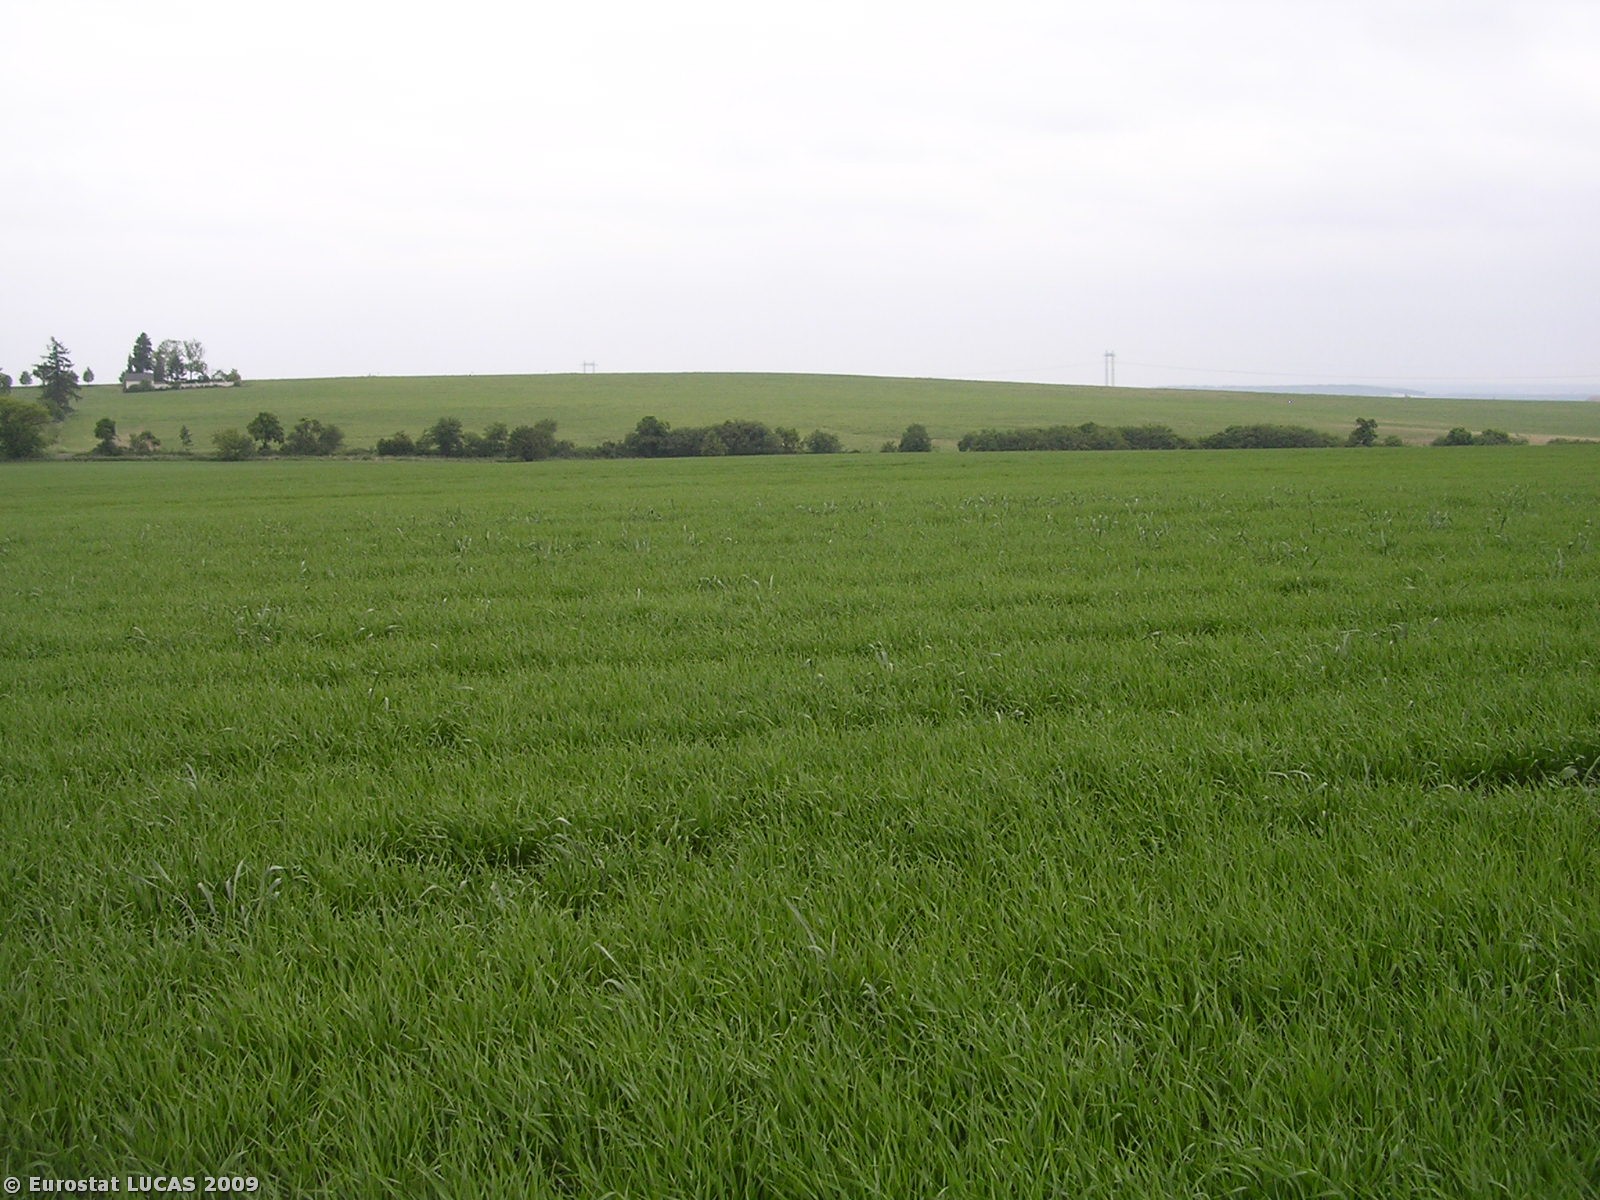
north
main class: Cropland
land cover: Barley
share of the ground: > 75 %
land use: Agriculture (excluding fallow land and kitchen gardens)
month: May
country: CZ
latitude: 50.1001
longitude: 14.8255
